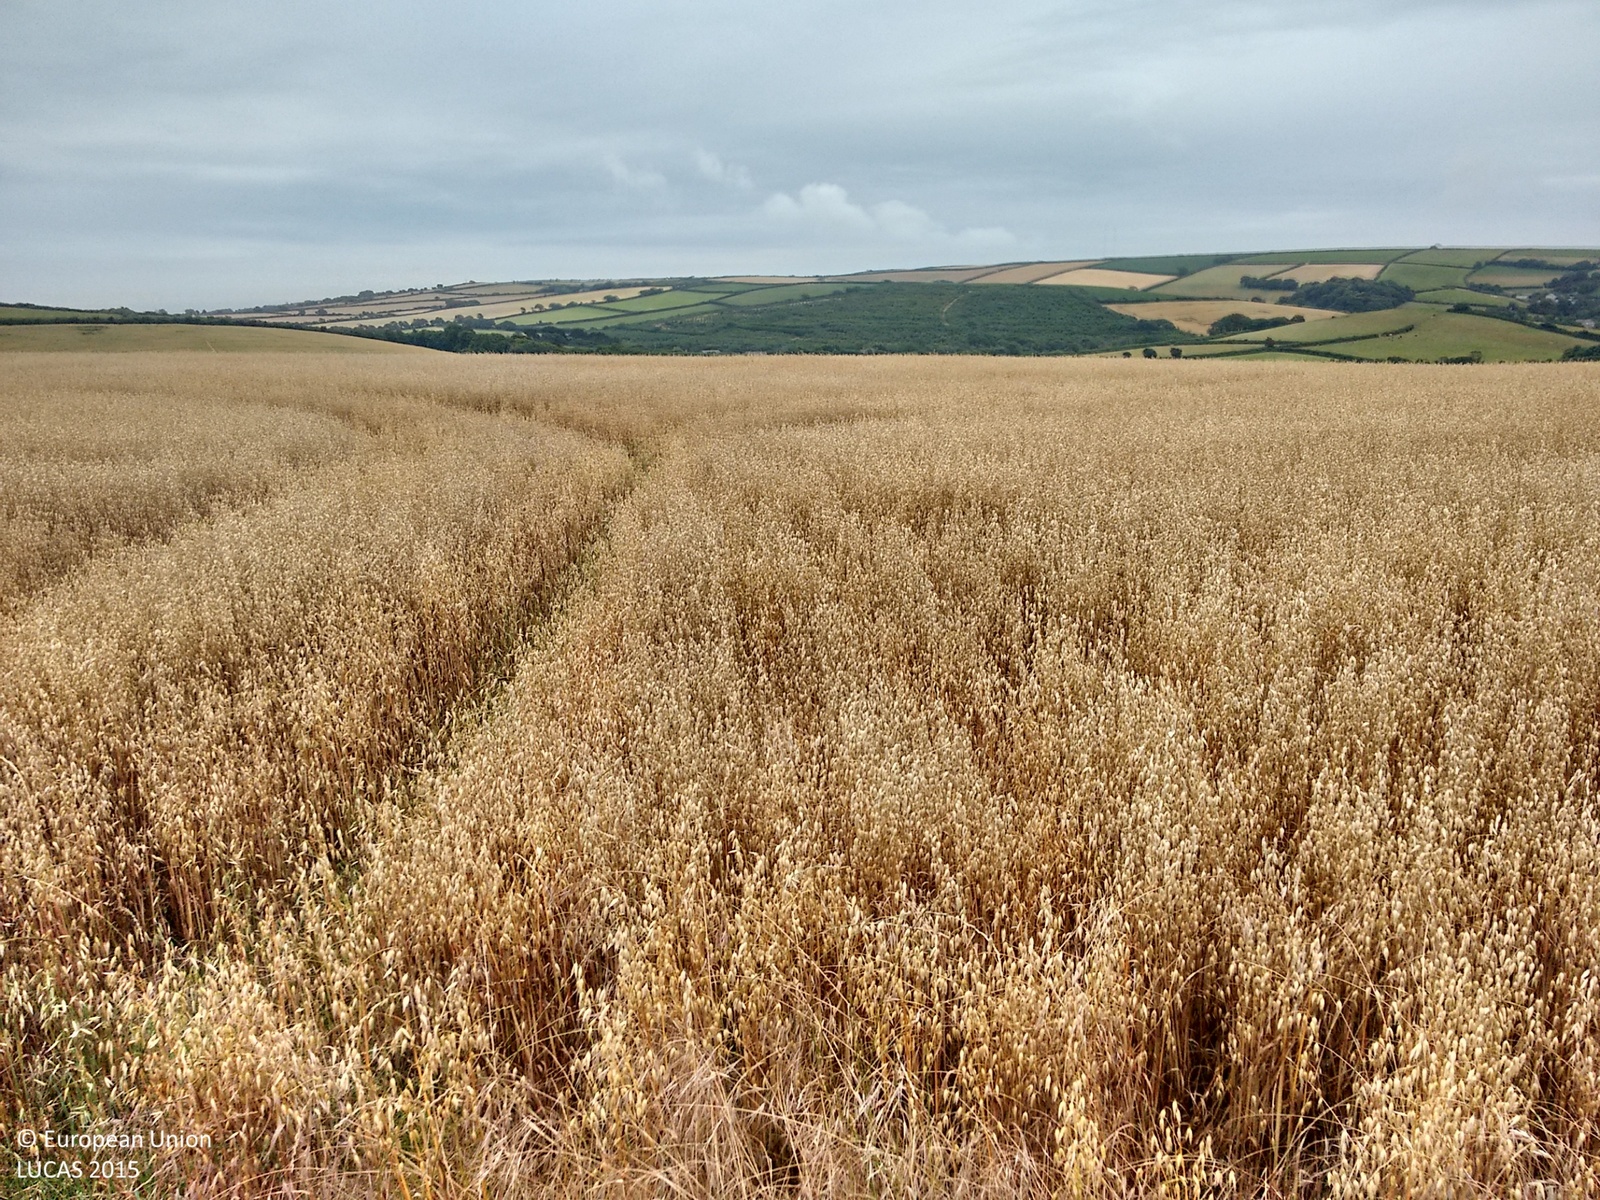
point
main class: Cropland
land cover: Oats
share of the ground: > 75 %
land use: Agriculture (excluding fallow land and kitchen gardens)
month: August
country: GB
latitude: 50.2634
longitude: -3.7088
